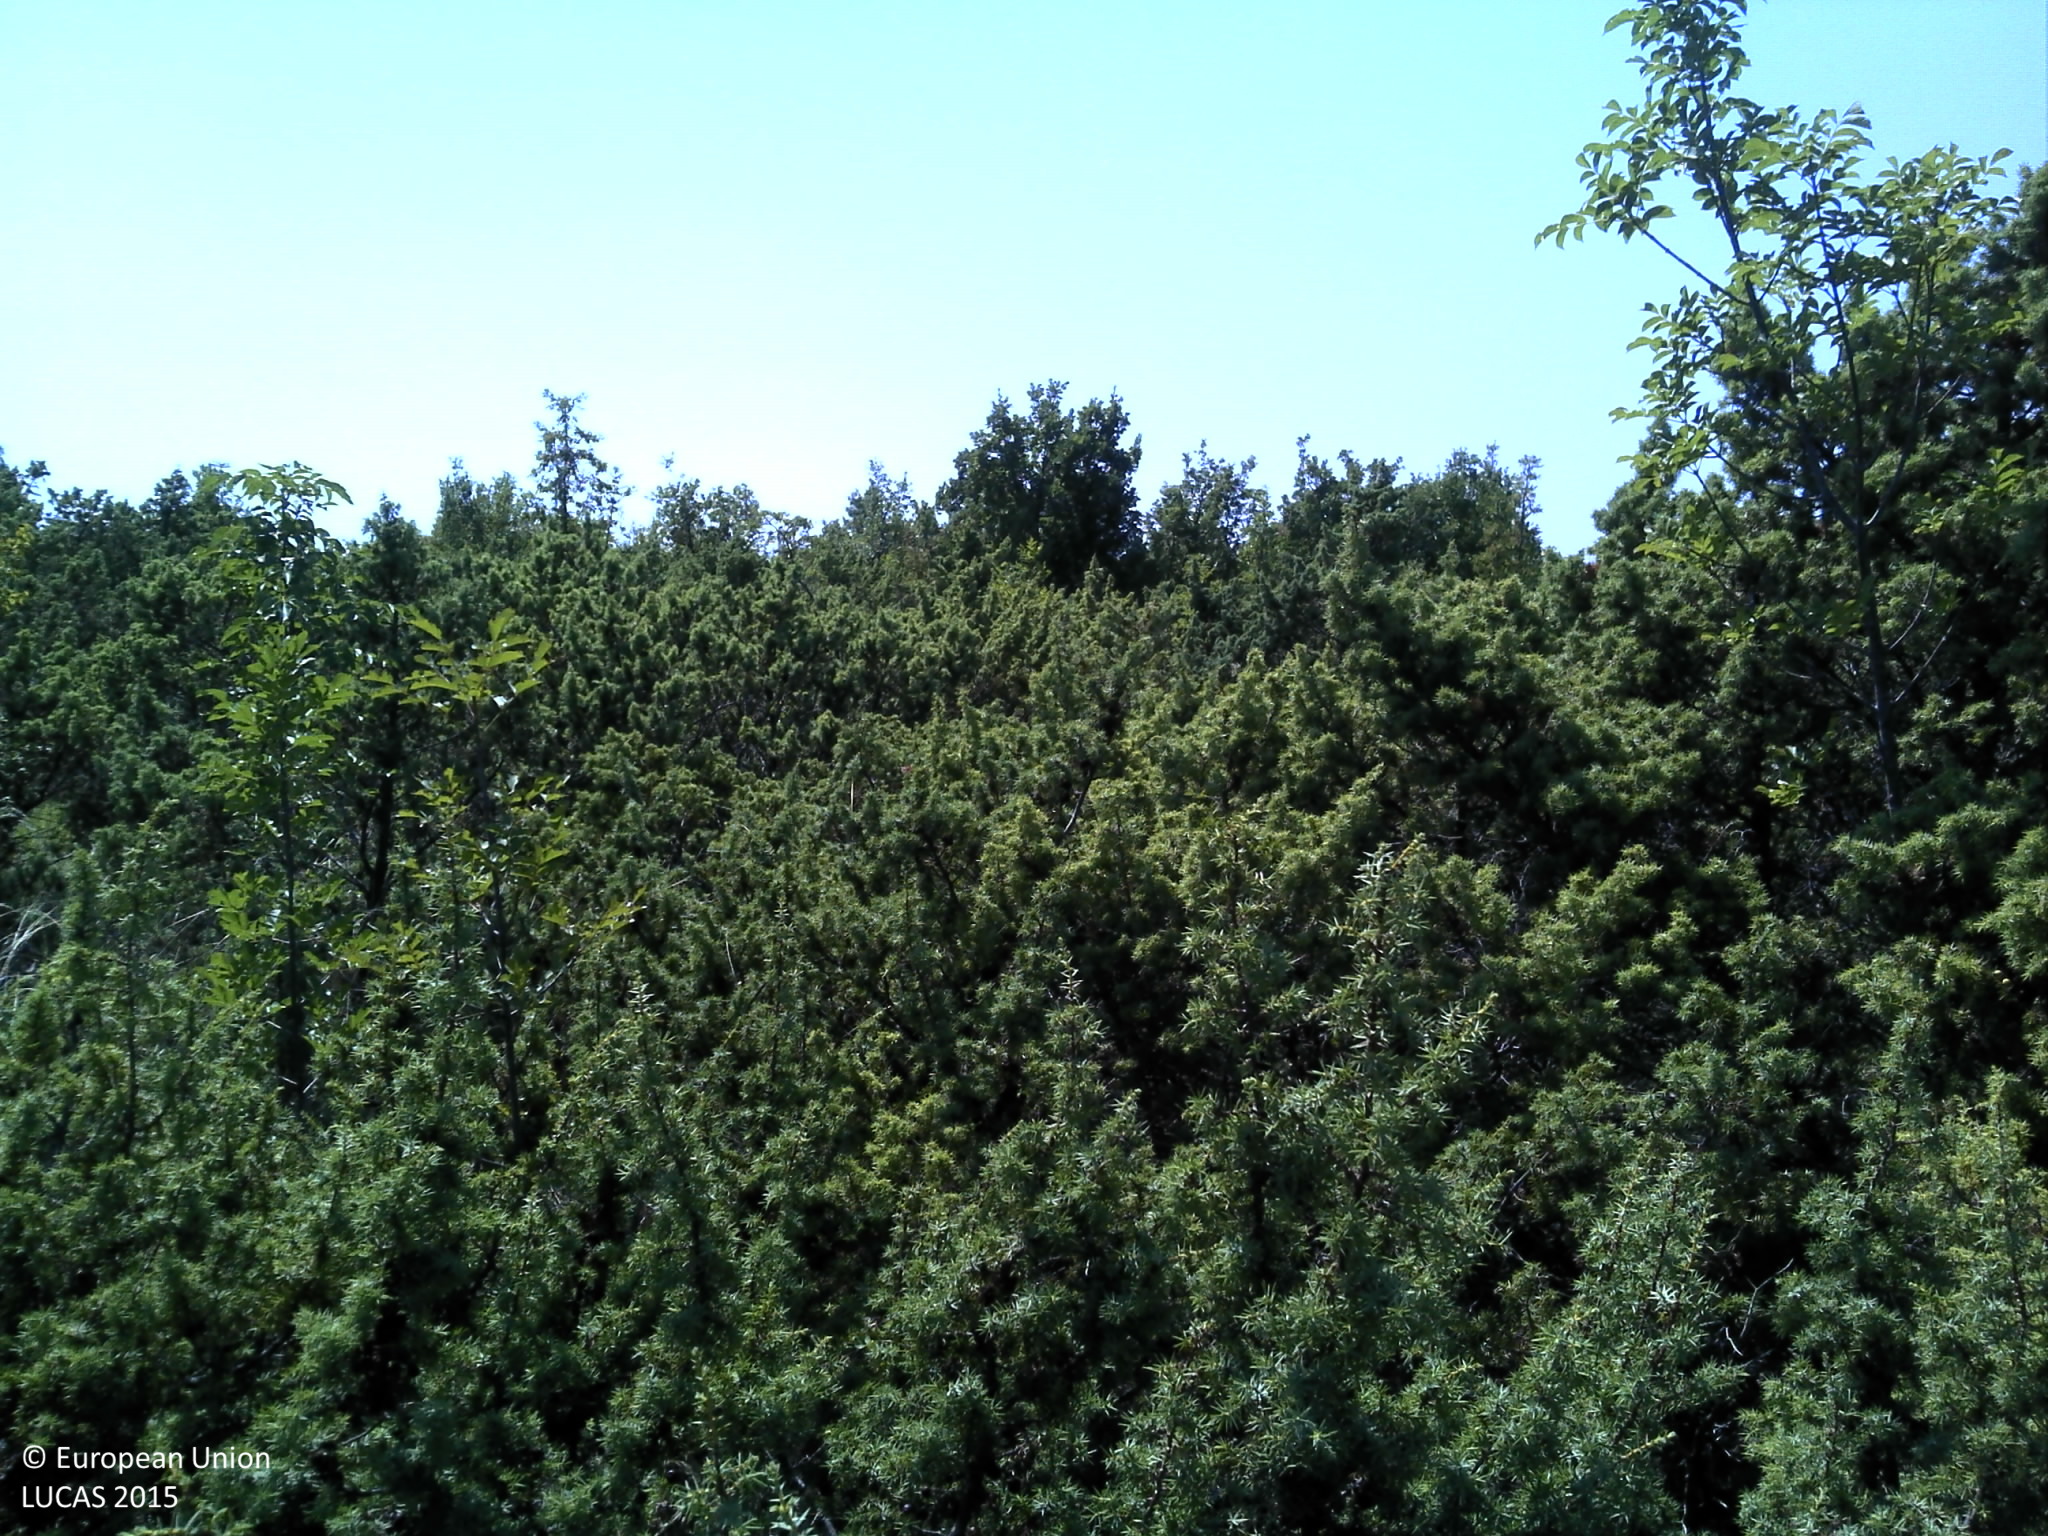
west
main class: Shrubland
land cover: Shrubland with sparse tree cover
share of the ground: > 75 %
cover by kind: shrubs 80 %, consolidated bare surface 10 %, coniferous forest trees 5 %, herbaceous plants 5 %
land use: Semi-natural and natural areas not in use
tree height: < 5 m
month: August
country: HR
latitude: 43.9996
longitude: 15.6161
